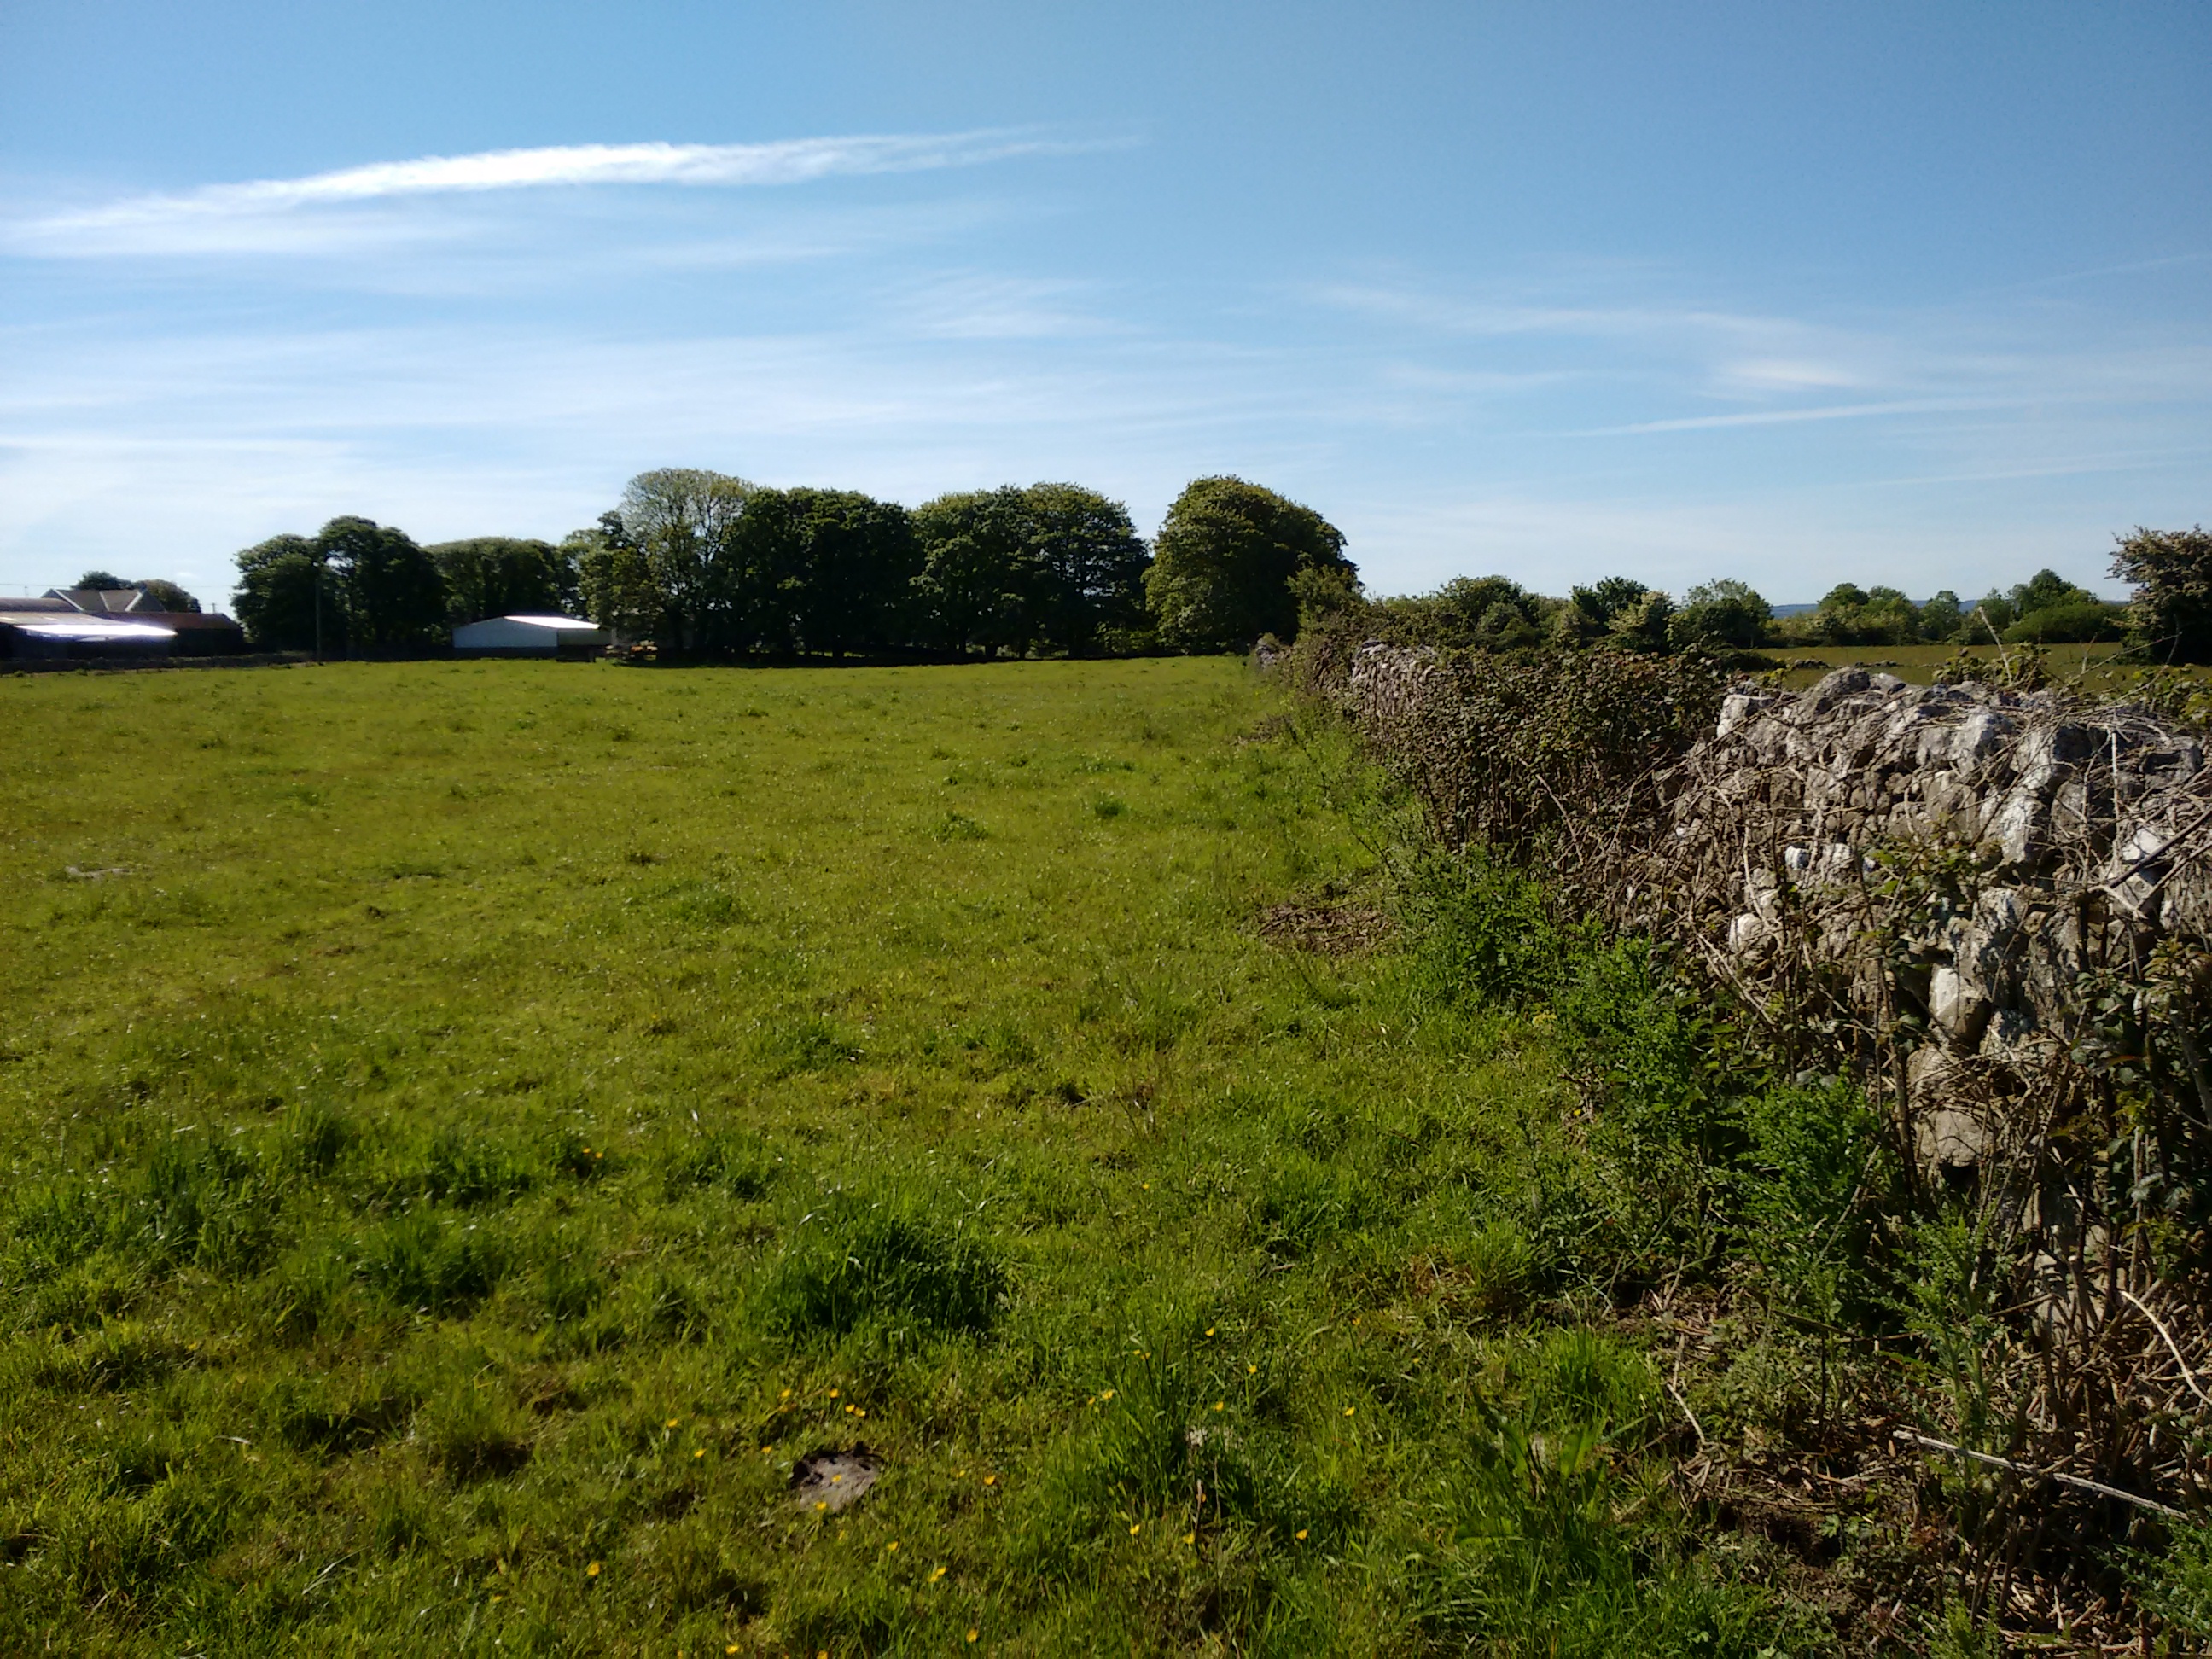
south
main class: Grassland
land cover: Grassland without tree/shrub cover
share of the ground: > 75 %
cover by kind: herbaceous plants 100 %
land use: Agriculture (excluding fallow land and kitchen gardens)
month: June
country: IE
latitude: 53.2167
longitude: -8.6026
